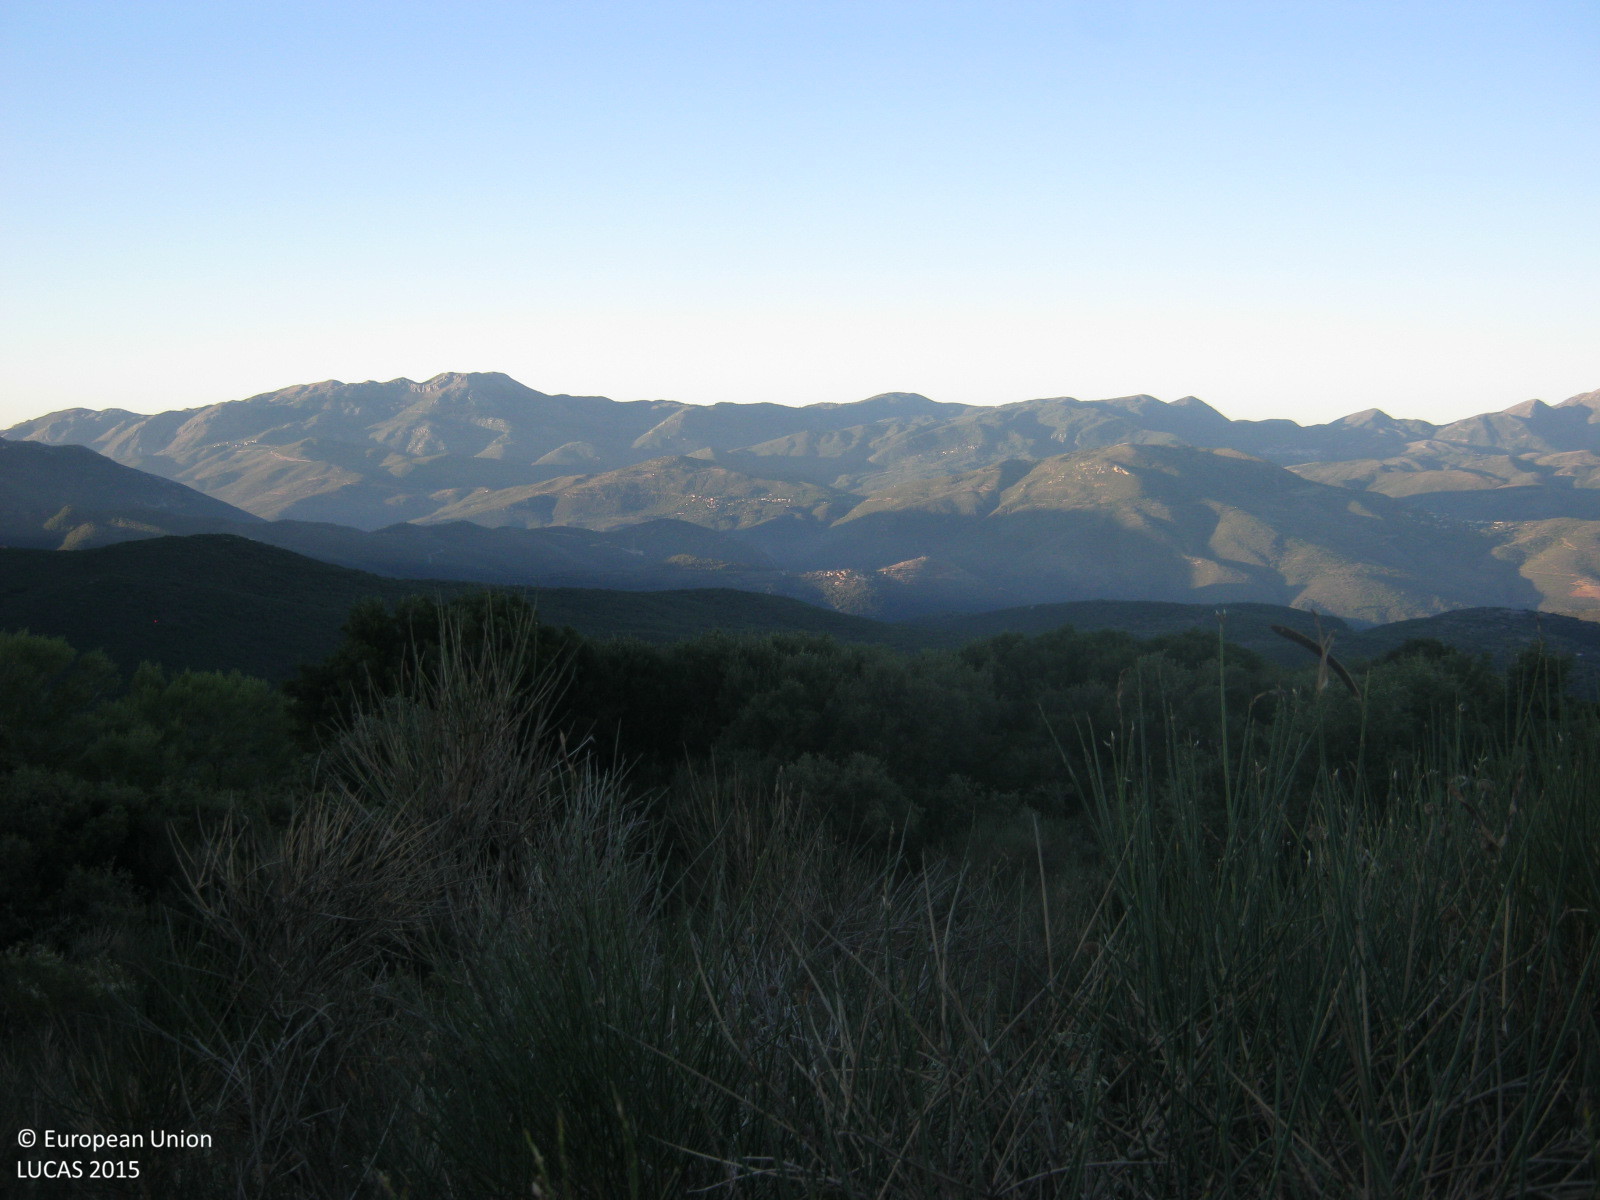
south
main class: Shrubland
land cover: Shrubland with sparse tree cover
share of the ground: > 75 %
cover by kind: shrubs 95 %, broadleaved forest trees 5 %
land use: Semi-natural and natural areas not in use
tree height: > 5 m
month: September
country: GR
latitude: 37.5920
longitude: 21.9767
